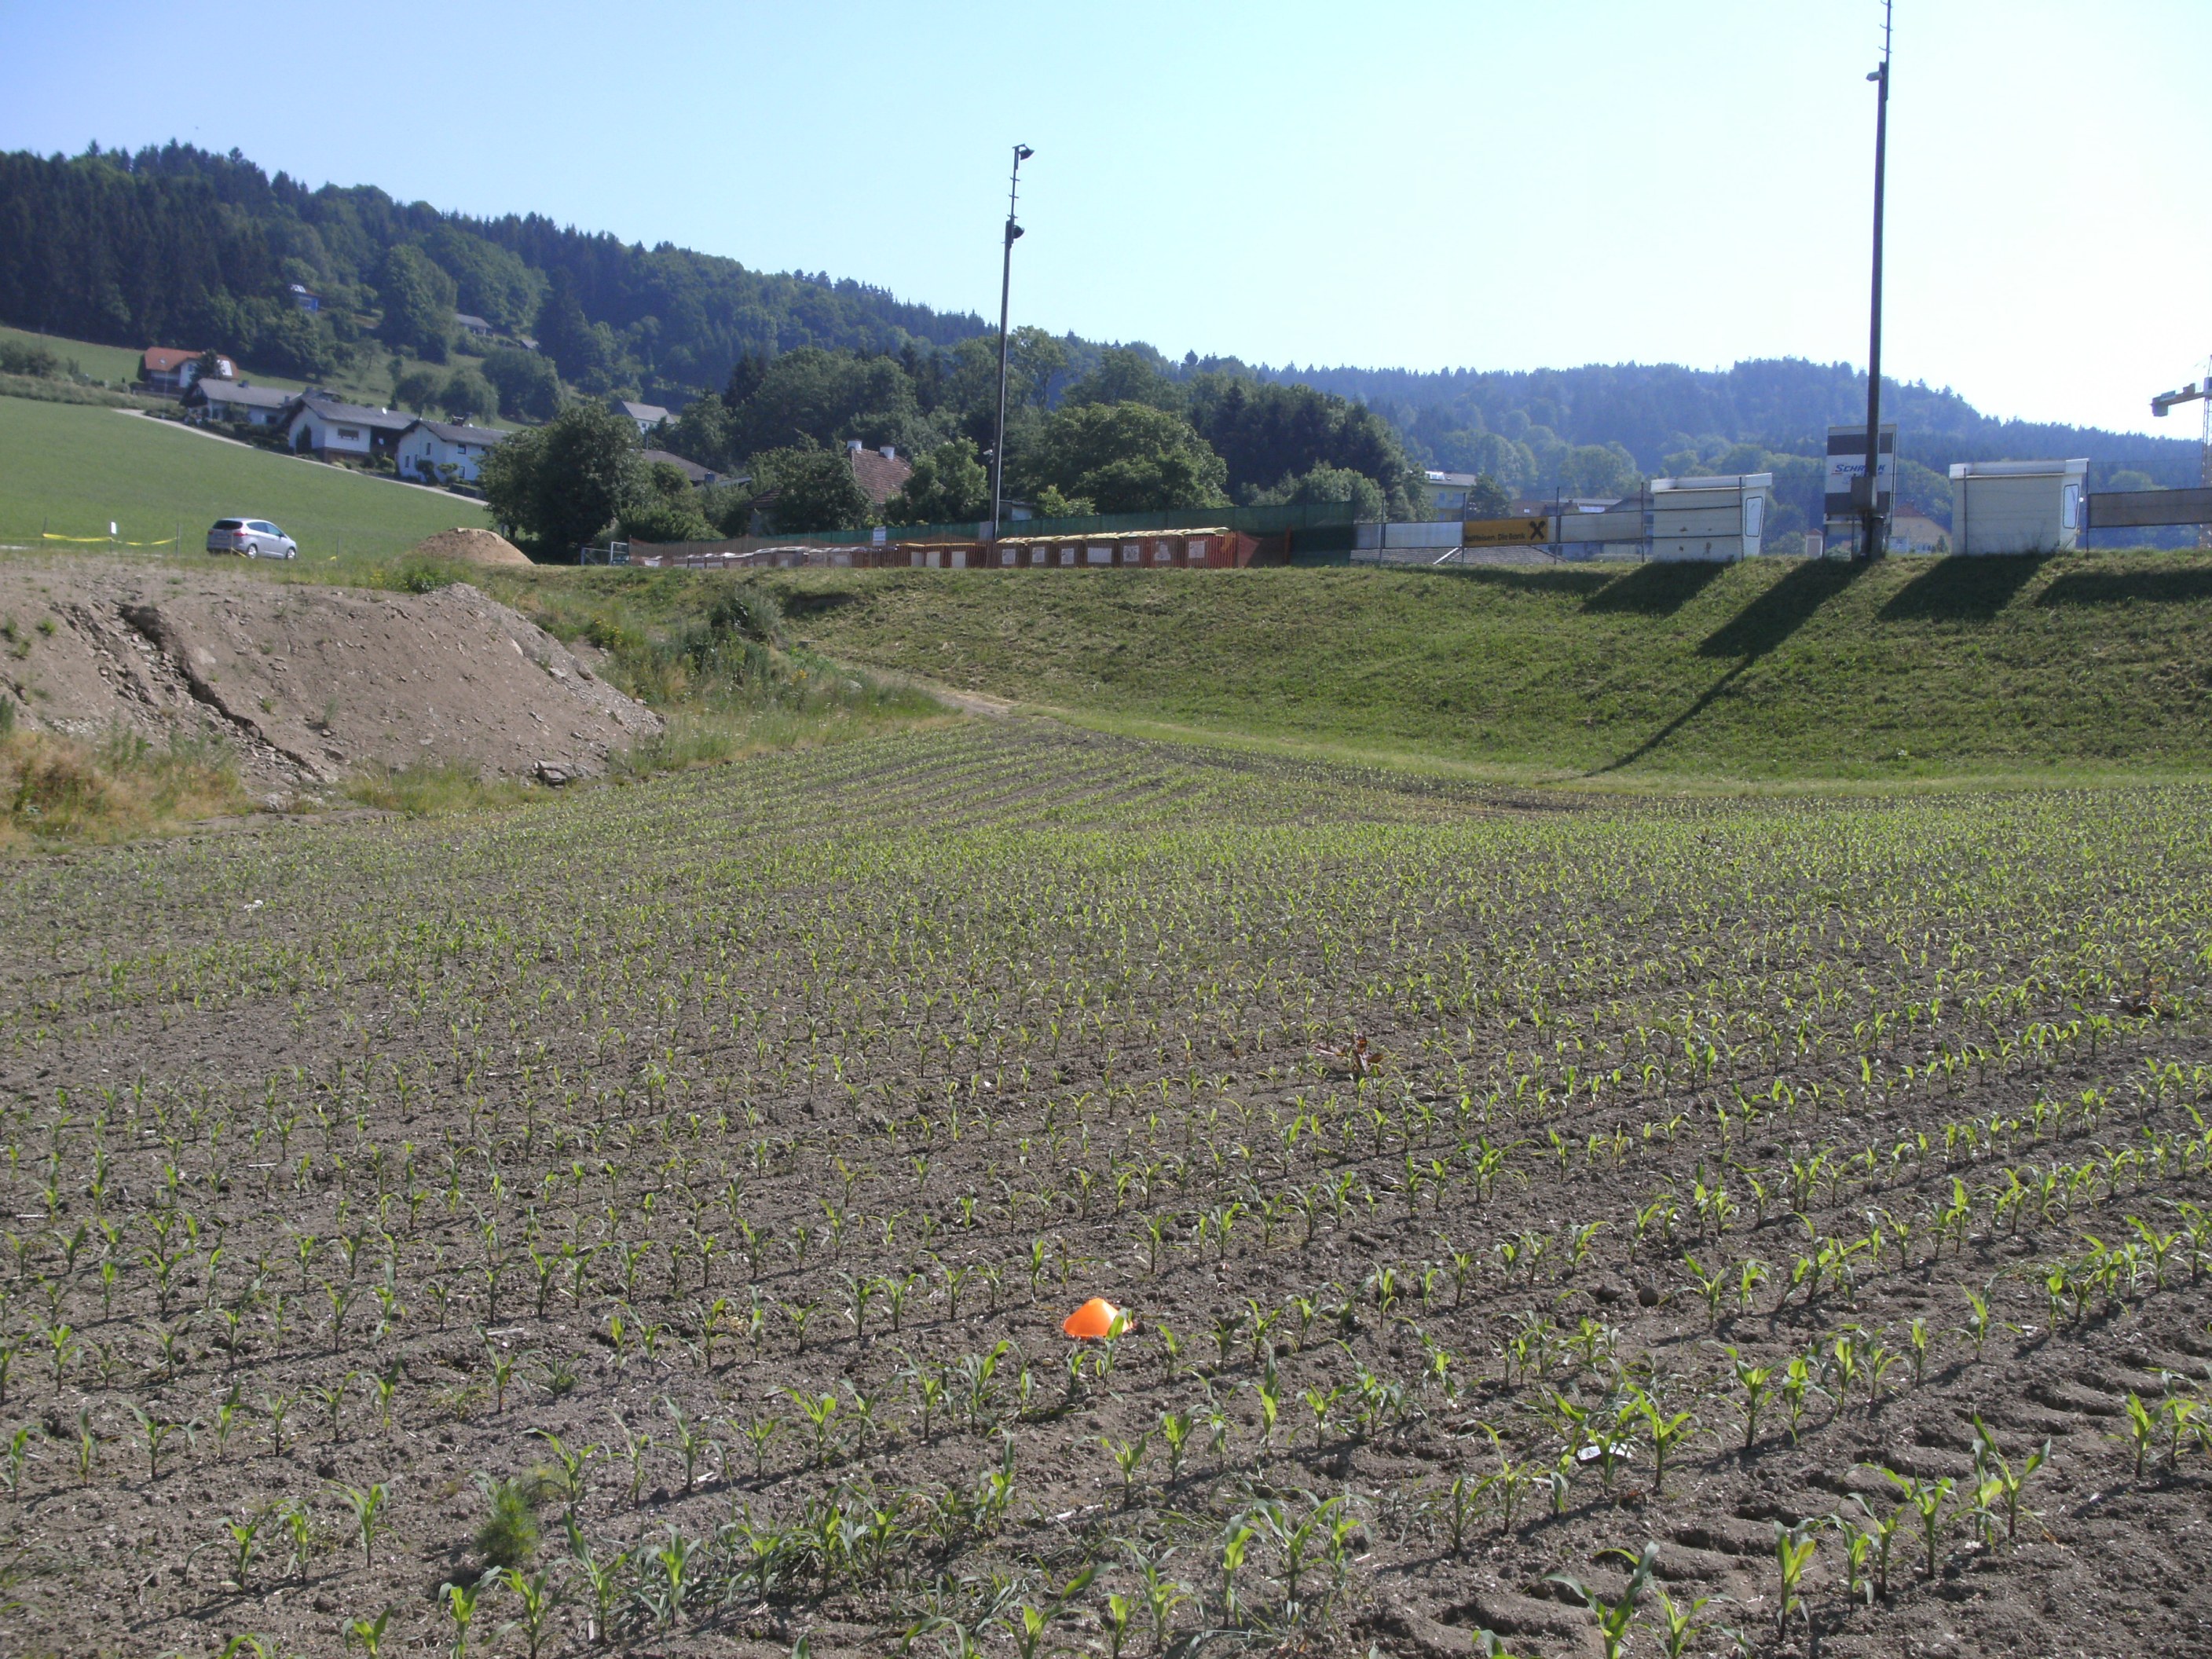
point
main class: Cropland
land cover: Maize
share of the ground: 10 - 25 %
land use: Agriculture (excluding fallow land and kitchen gardens)
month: June
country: AT
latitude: 48.3948
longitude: 14.2275
